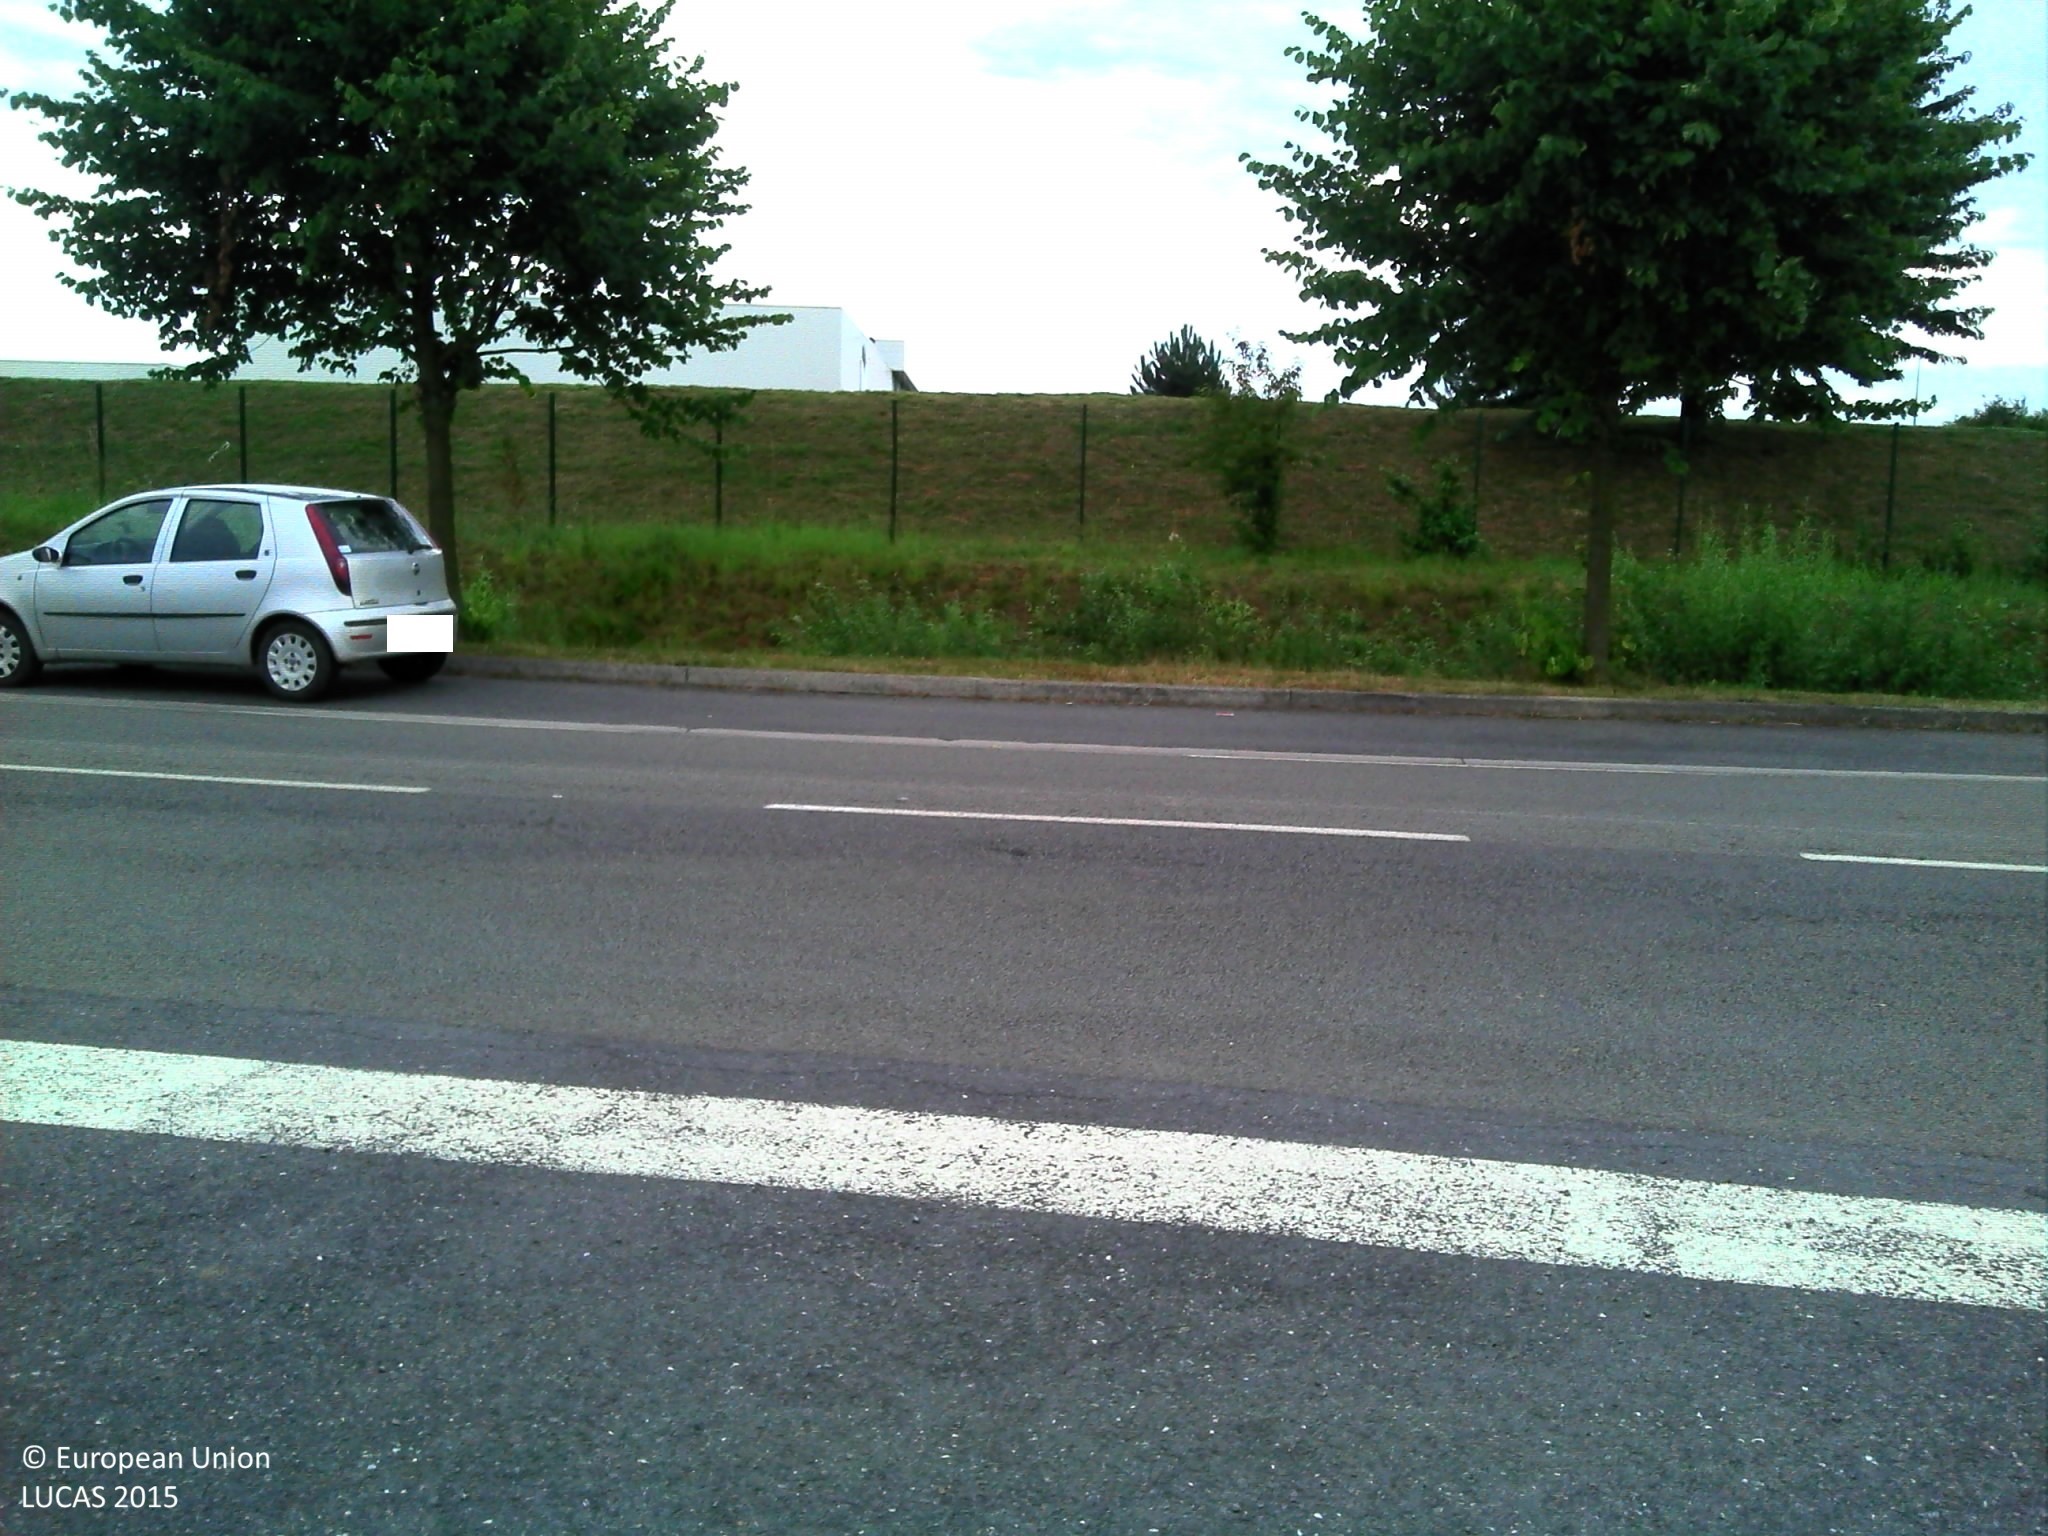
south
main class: Grassland
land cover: Grassland without tree/shrub cover
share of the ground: > 75 %
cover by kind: herbaceous plants 95 %, lichens and mosses 5 %
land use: Machinery and equipment
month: July
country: FR
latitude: 50.1975
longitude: 3.1968
